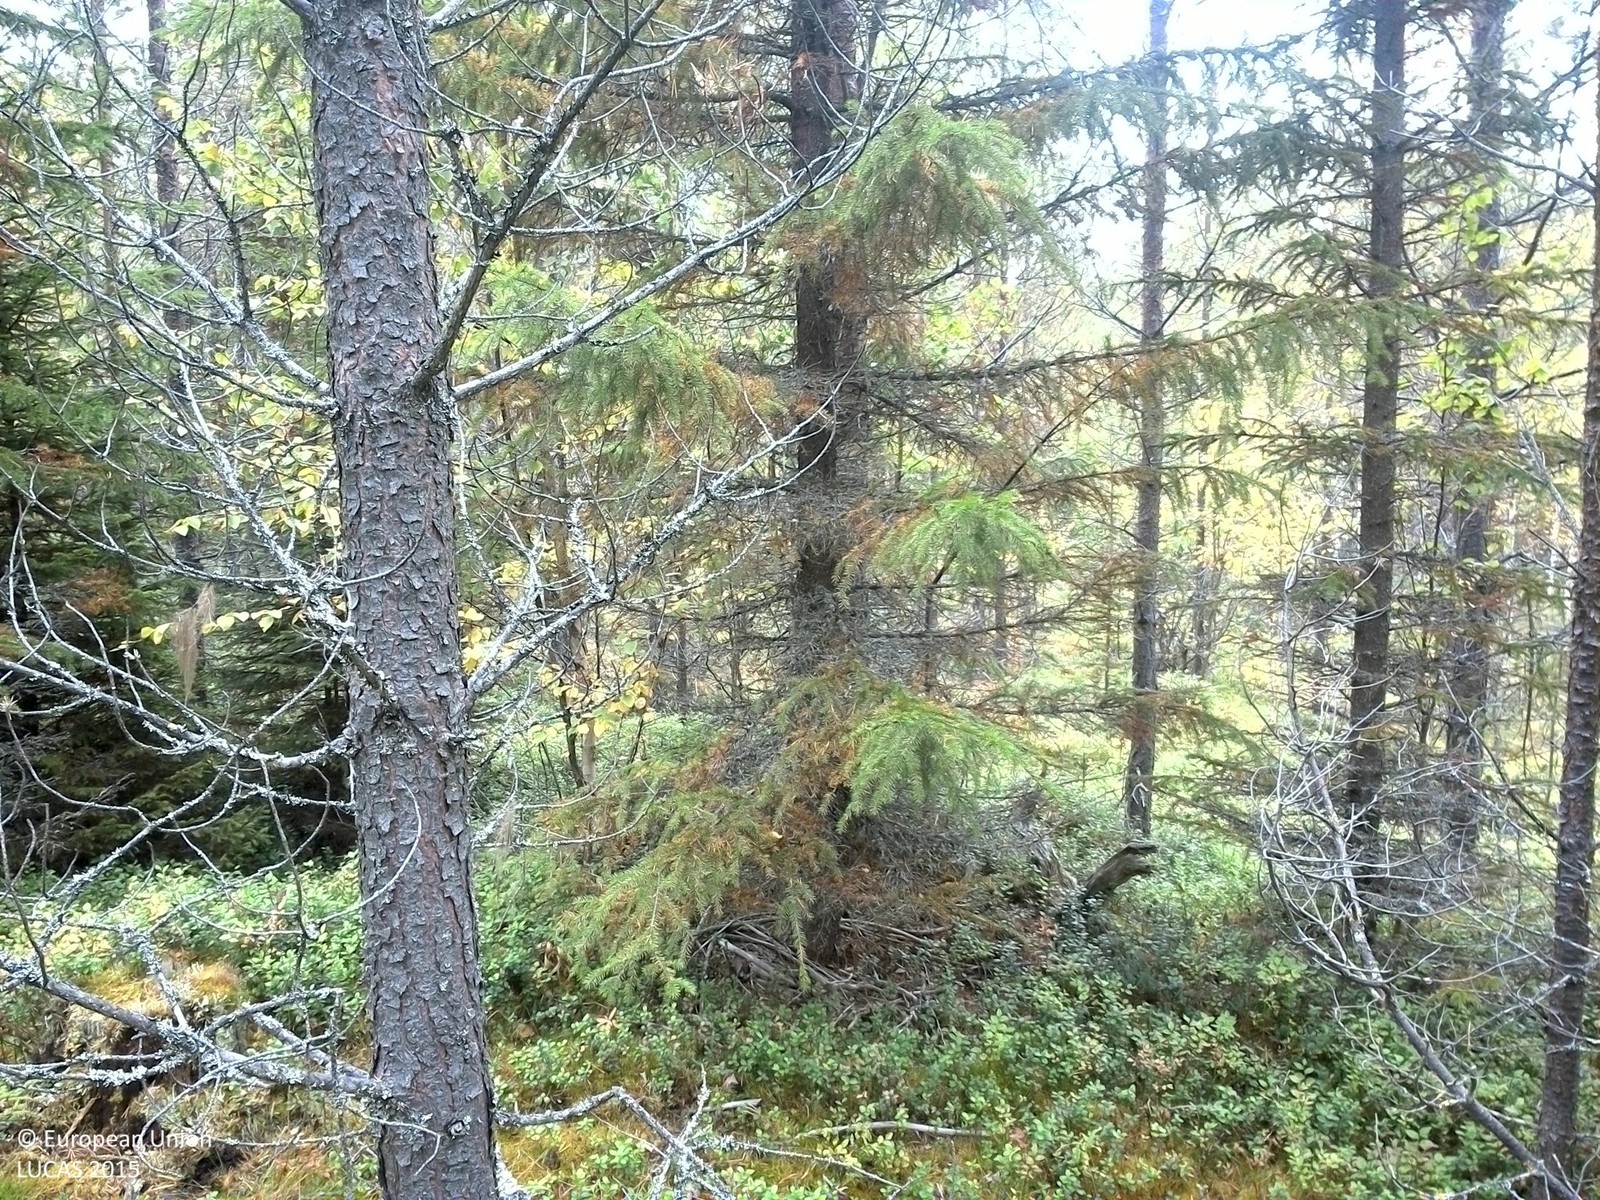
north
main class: Woodland
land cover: Pine dominated mixed woodland
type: boreal forest
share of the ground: 50 - 75 %
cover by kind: coniferous forest trees 45 %, shrubs 25 %, broadleaved forest trees 15 %, lichens and mosses 10 %, herbaceous plants 5 %
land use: Forestry
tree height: > 5 m
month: September
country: SE
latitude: 63.6067
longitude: 16.2038
